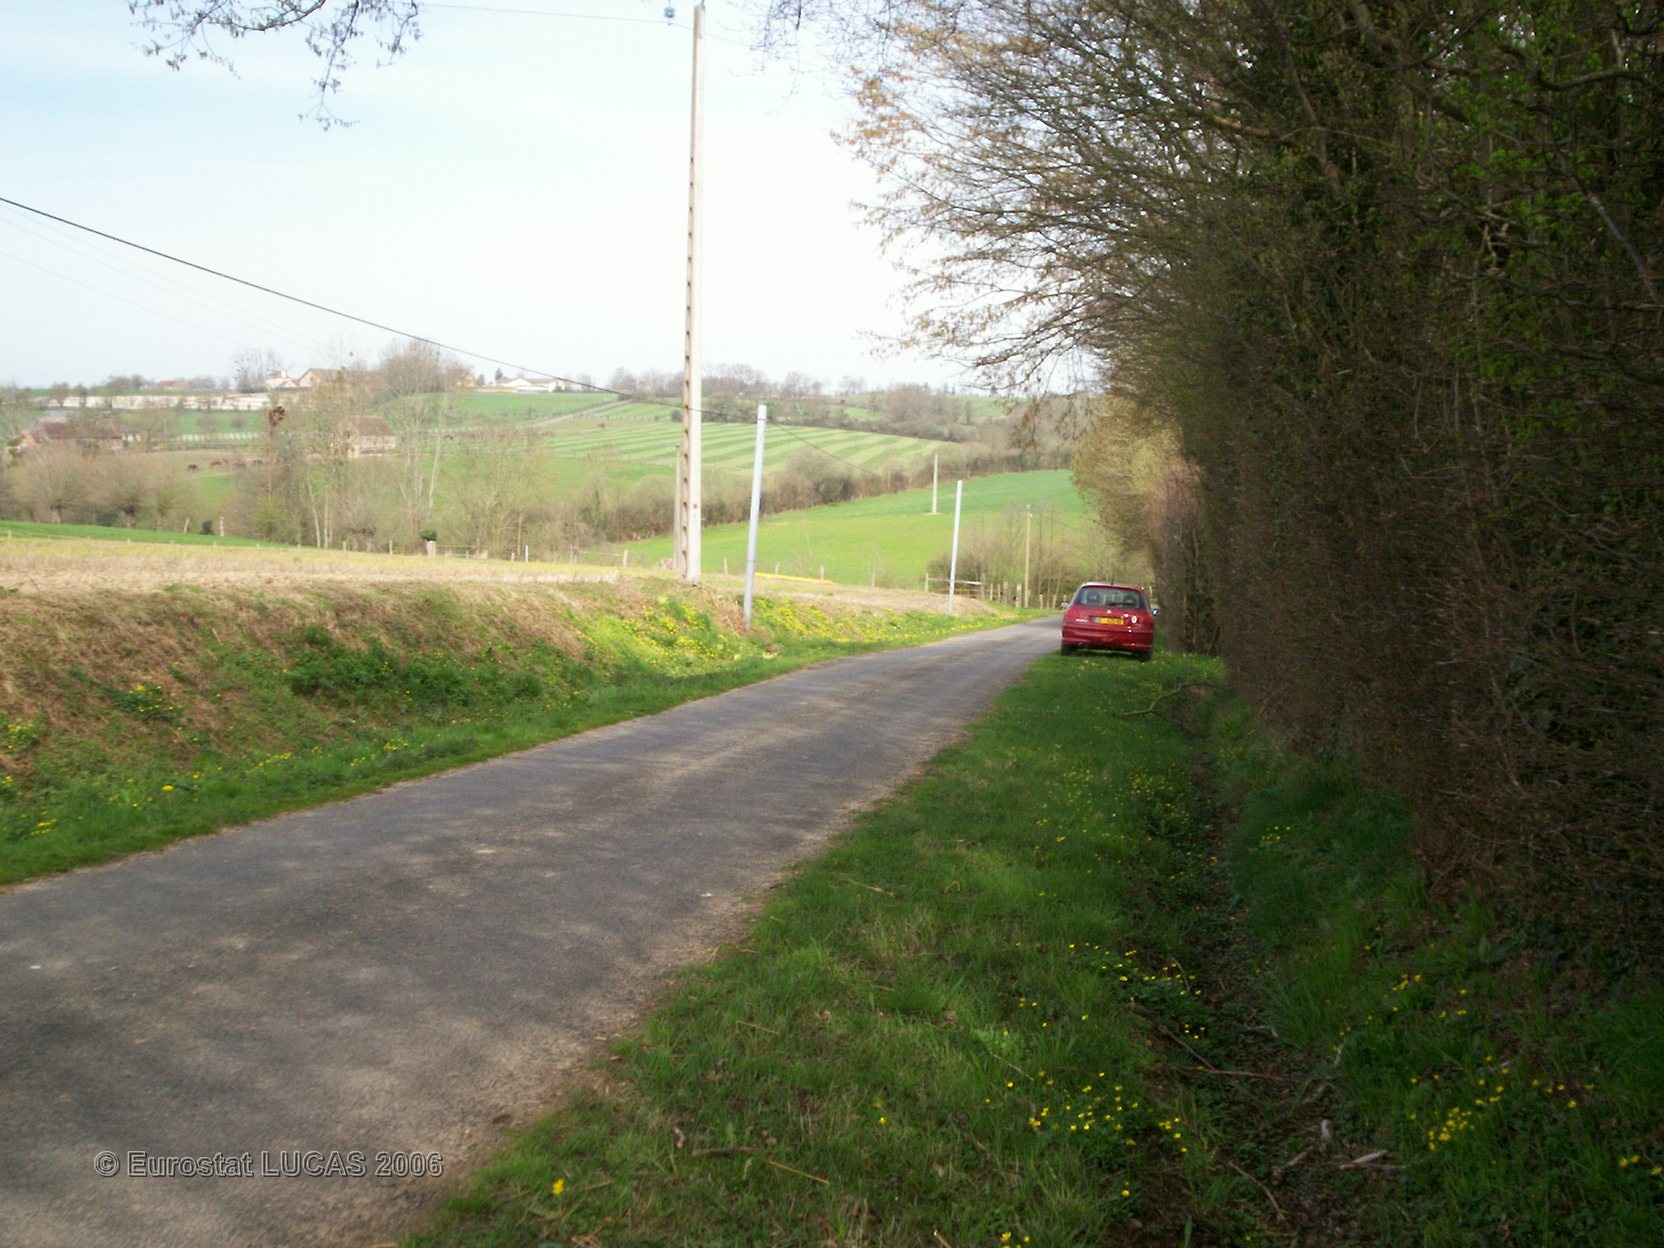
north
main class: Grassland
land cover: Grassland without tree/shrub cover
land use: Agriculture (excluding fallow land and kitchen gardens)
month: April
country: FR
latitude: 48.7506
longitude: 0.2476
